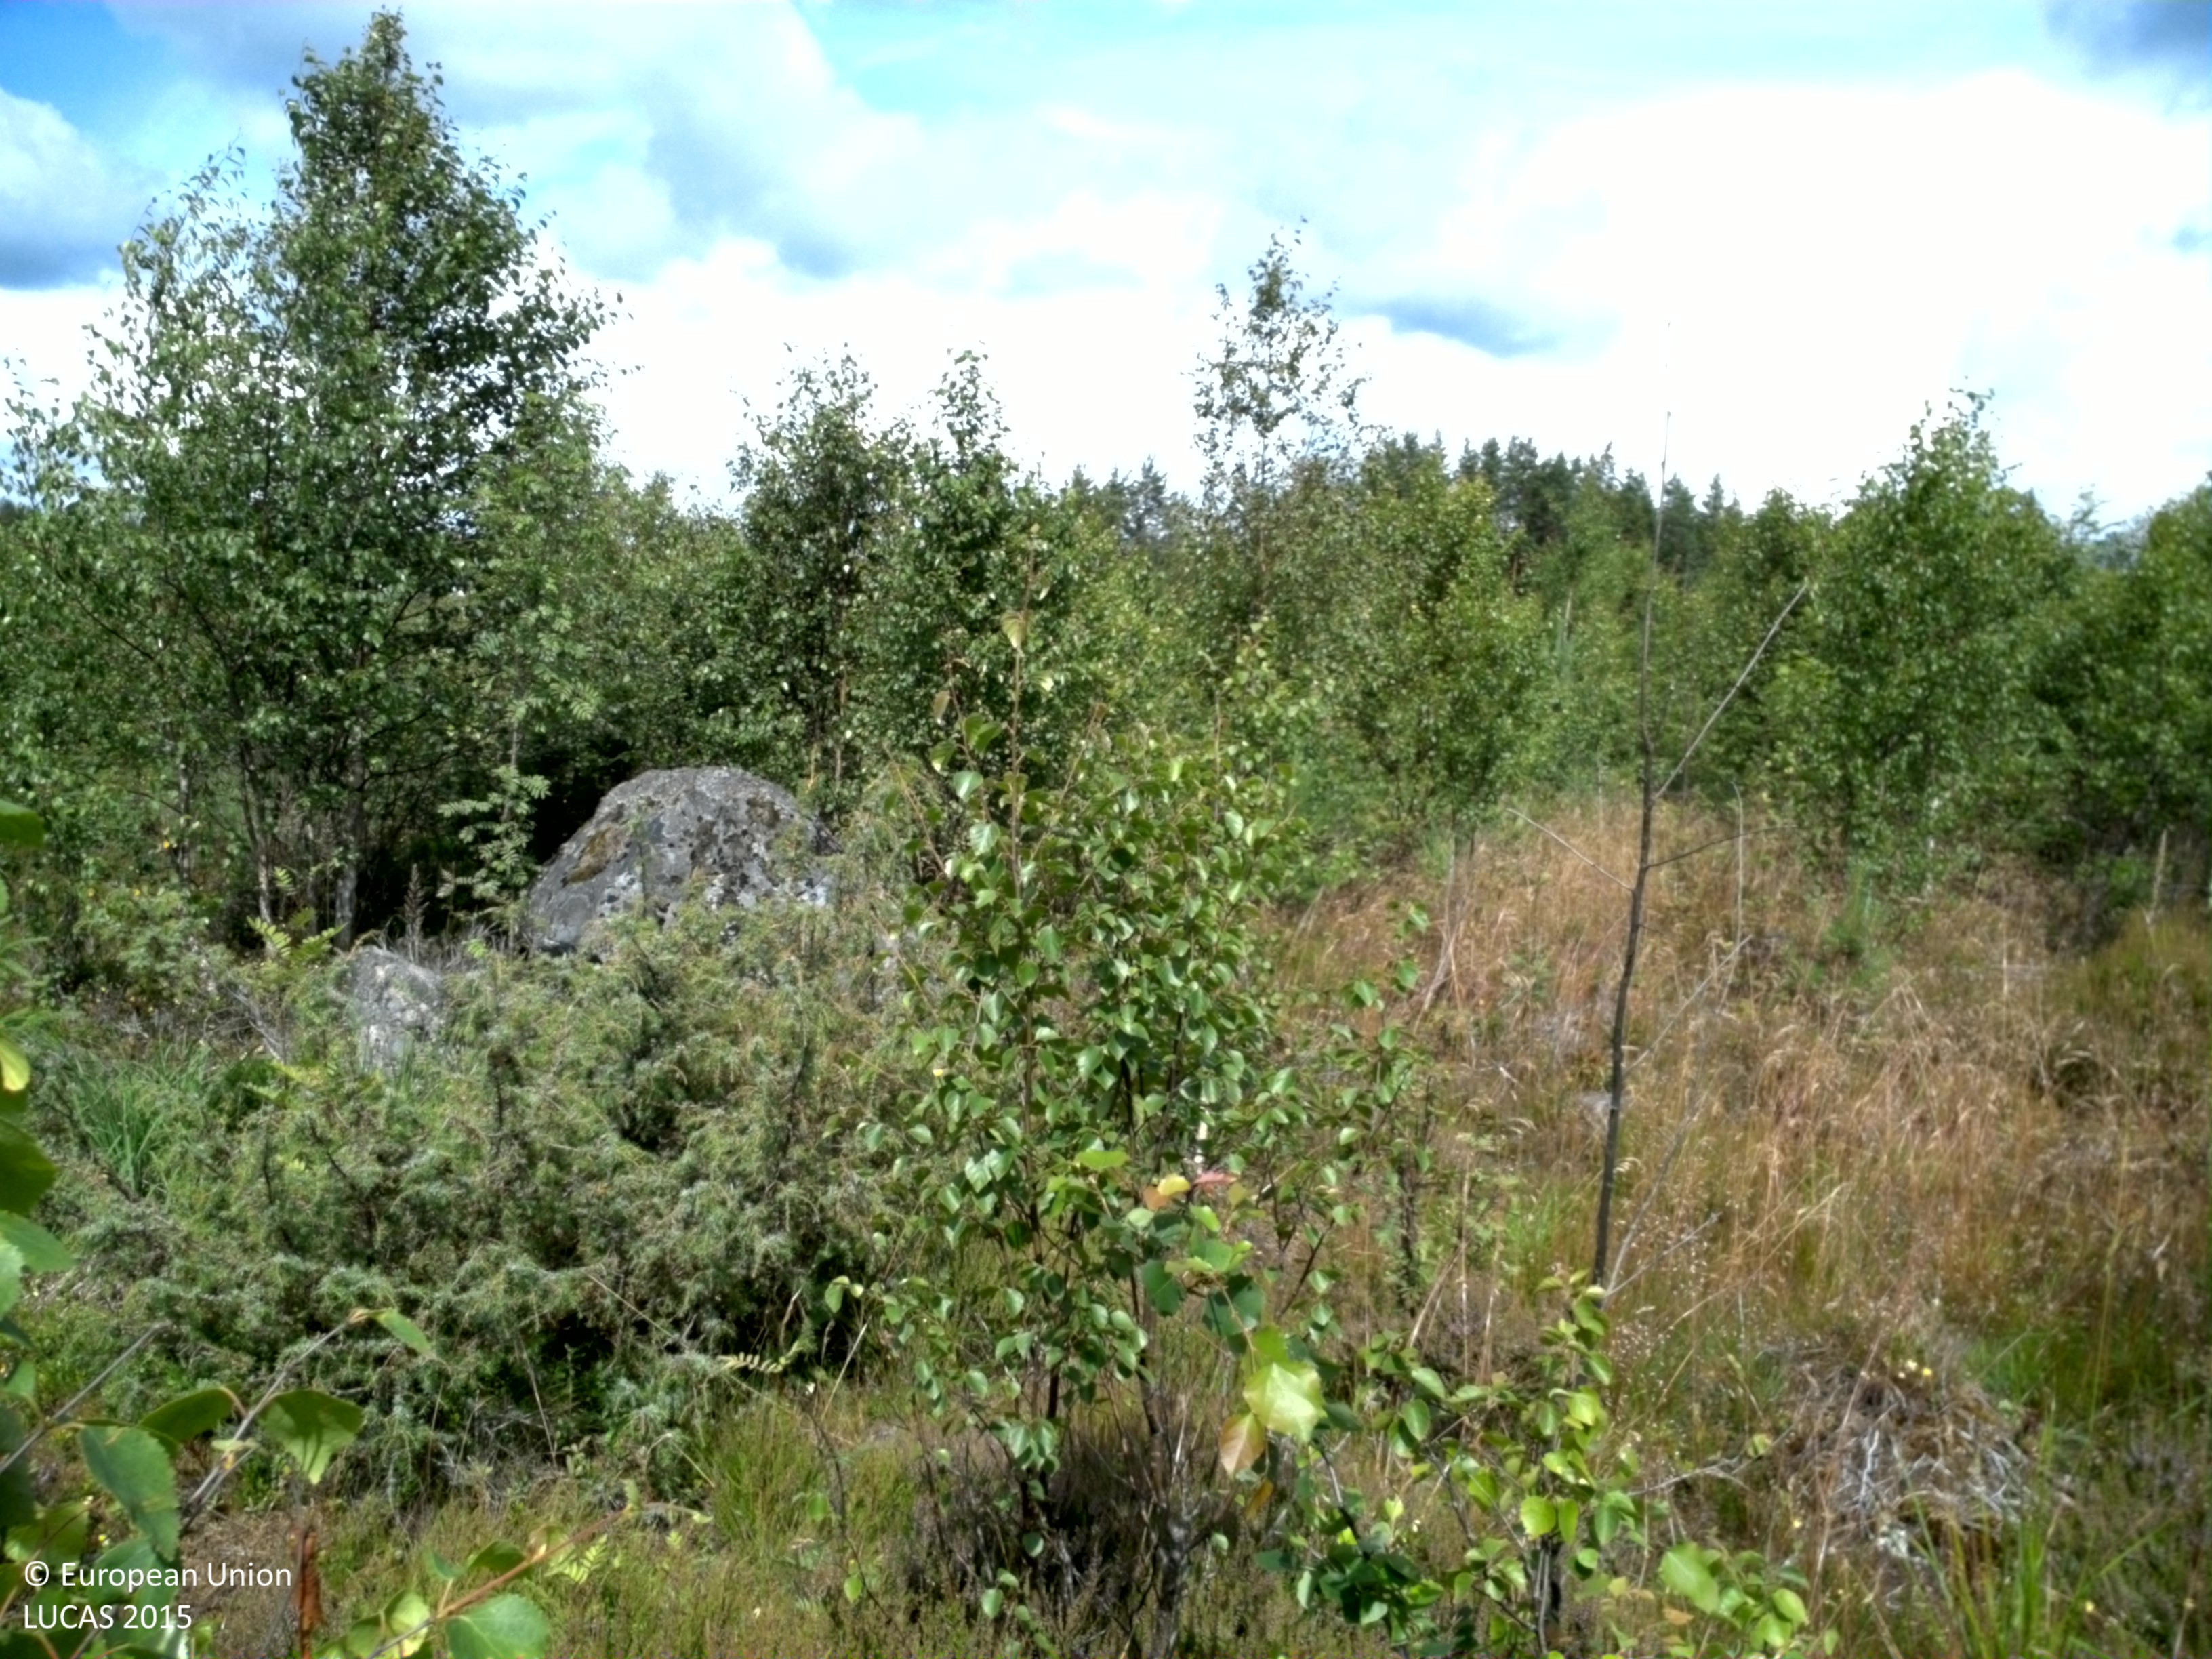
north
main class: Woodland
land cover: Broadleaved woodland
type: hemiboreal forest and nemoral coniferous forest and mixed broadleaved-coniferous forest
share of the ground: 25 - 50 %
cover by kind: broadleaved forest trees 35 %, herbaceous plants 35 %, shrubs 15 %, lichens and mosses 10 %, coniferous forest trees 5 %
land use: Forestry
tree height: < 5 m
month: July
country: SE
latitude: 58.9866
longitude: 14.6383
